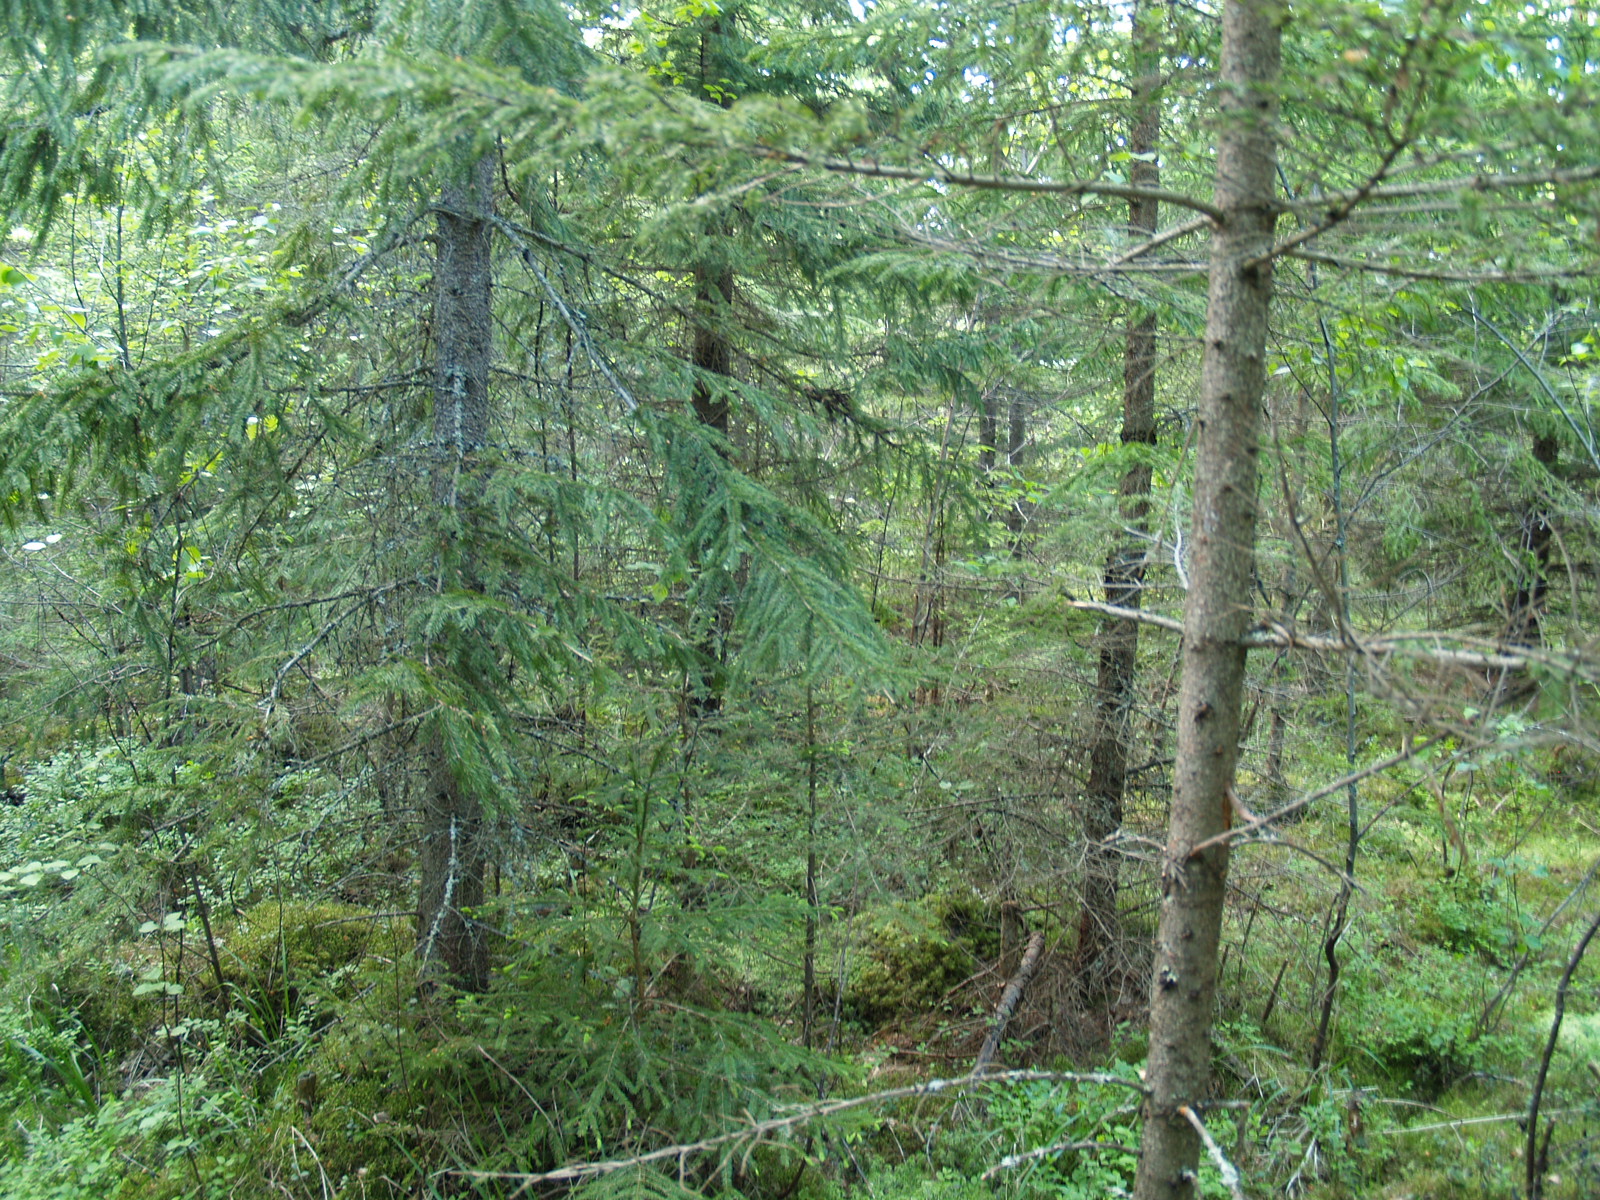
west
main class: Woodland
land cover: Spruce dominated coniferous woodland
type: hemiboreal forest and nemoral coniferous forest and mixed broadleaved-coniferous forest
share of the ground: > 75 %
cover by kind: coniferous forest trees 80 %, herbaceous plants 10 %, broadleaved forest trees 5 %, lichens and mosses 5 %
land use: Forestry
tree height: > 5 m
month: June
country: LV
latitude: 56.6353
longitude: 25.6274
